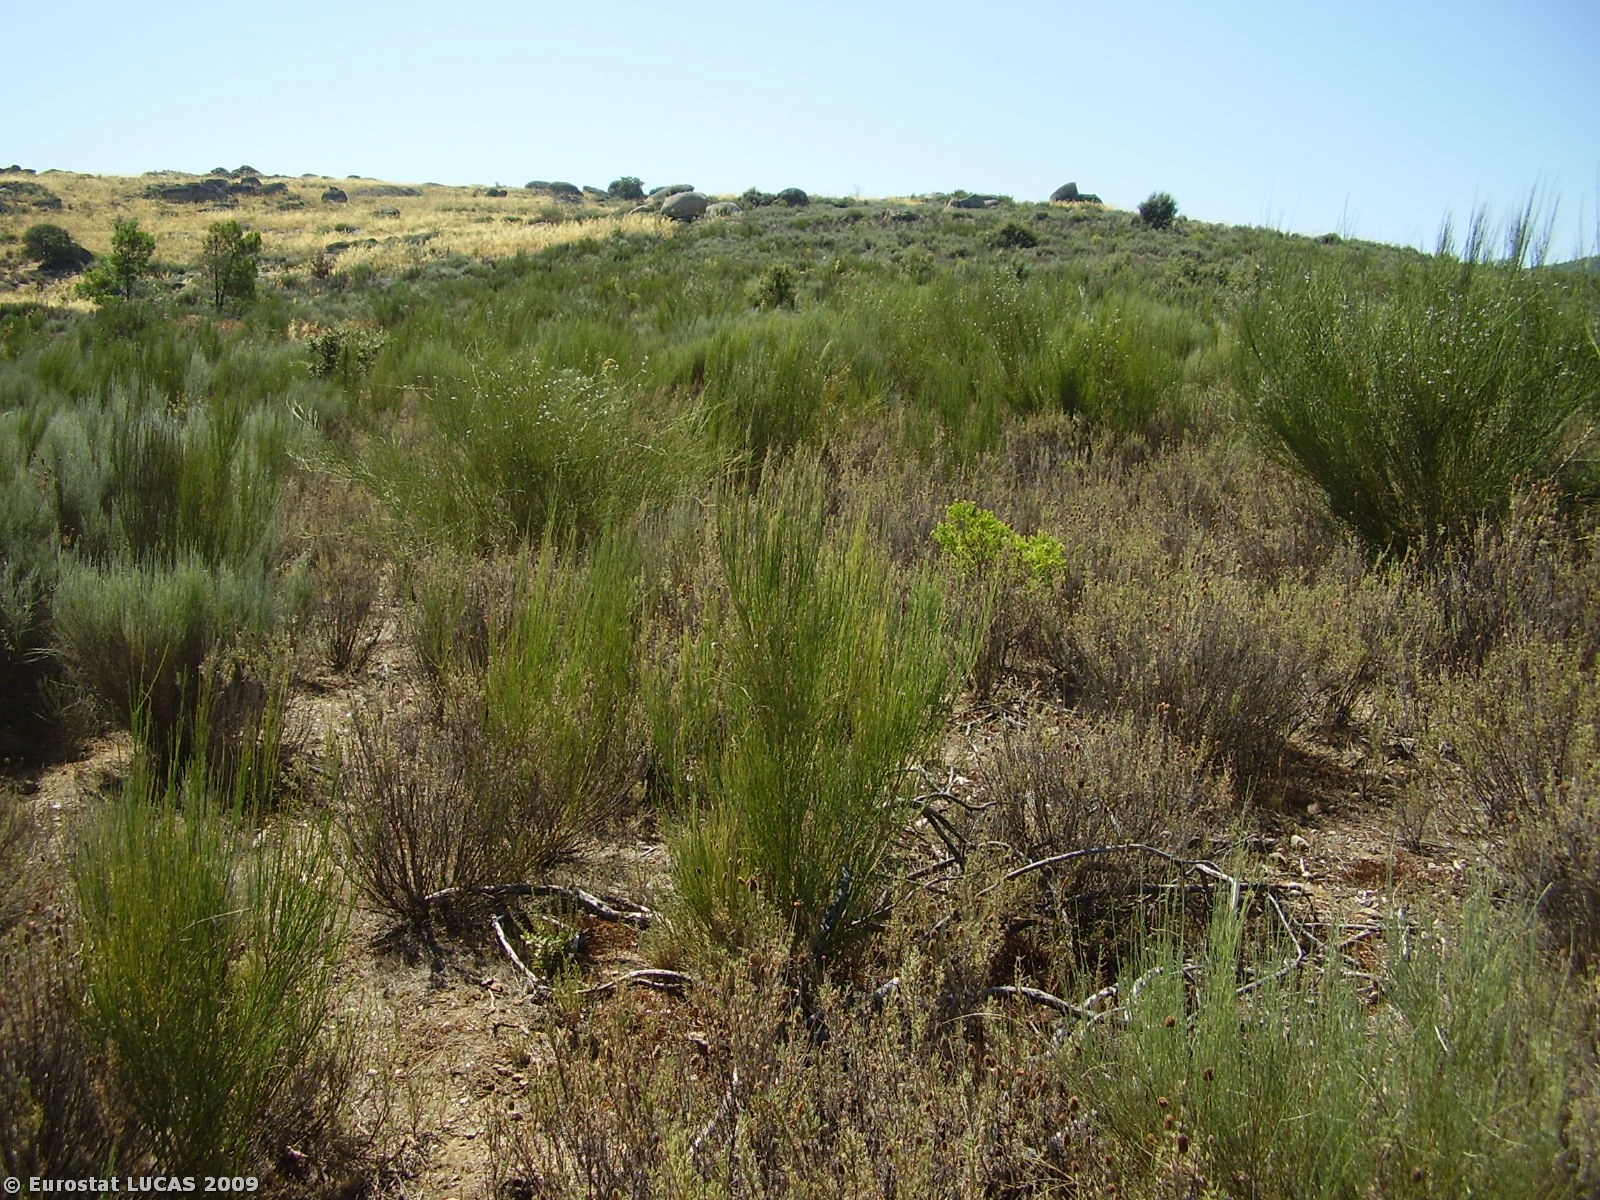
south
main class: Shrubland
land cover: Shrubland without tree cover
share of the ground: > 75 %
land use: Fallow land
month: August
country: PT
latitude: 41.2296
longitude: -6.7467
